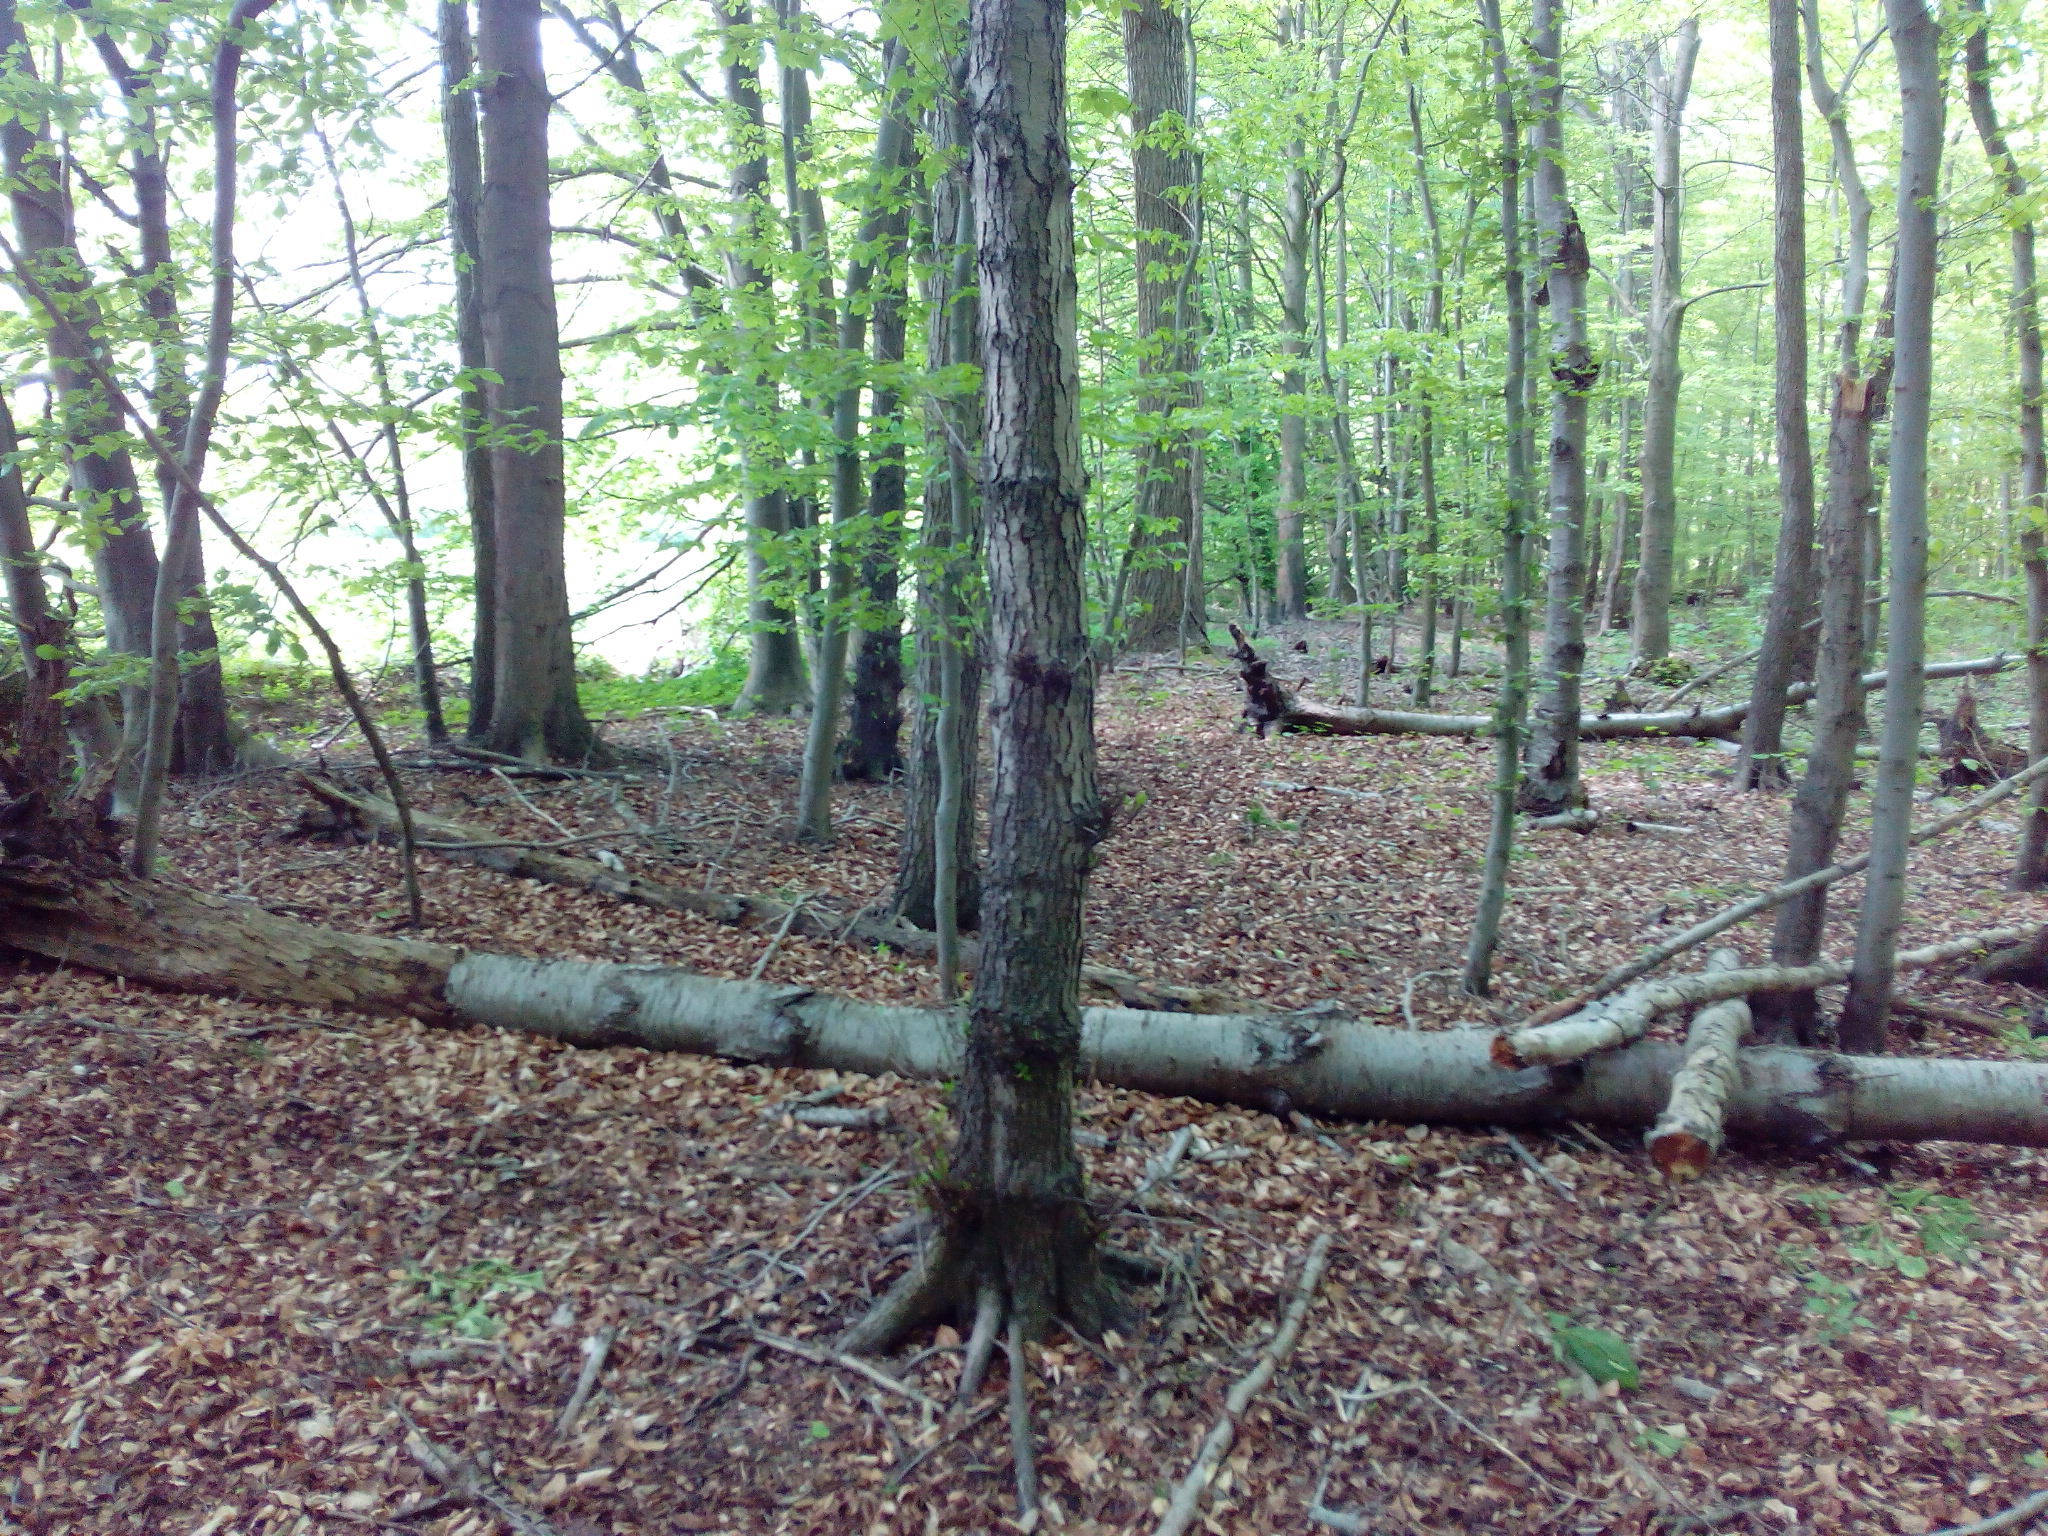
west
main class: Woodland
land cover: Broadleaved woodland
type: beech forest
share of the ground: > 75 %
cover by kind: broadleaved forest trees 95 %, herbaceous plants 5 %
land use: Forestry
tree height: > 5 m
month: May
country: DE
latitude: 52.3954
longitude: 9.8678
